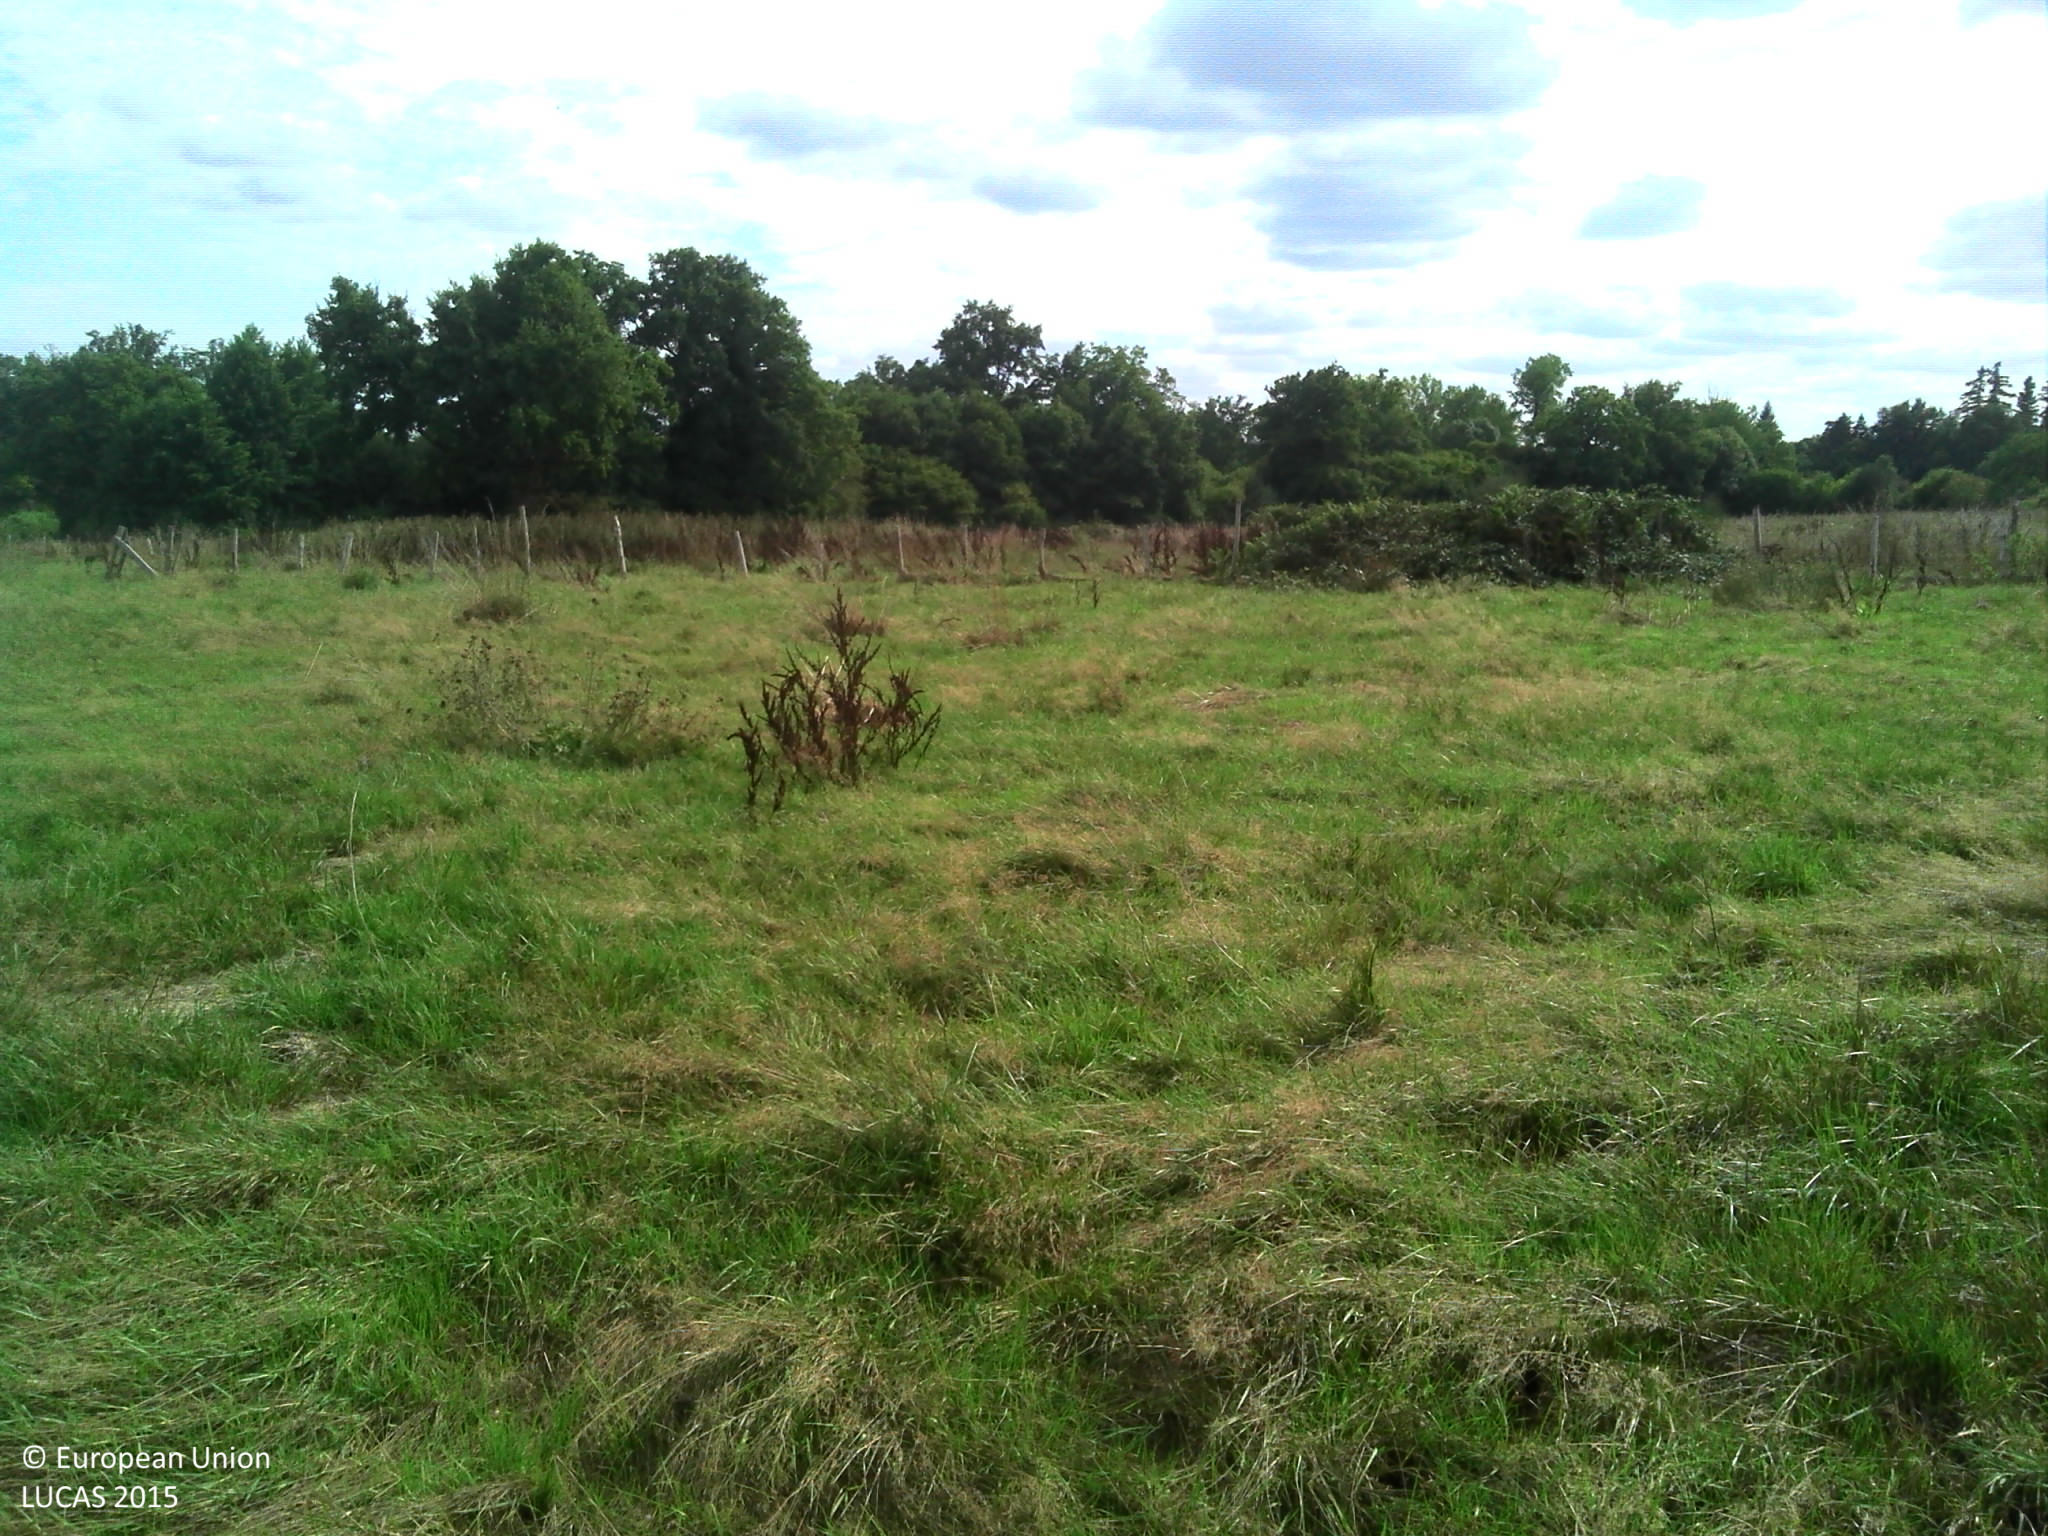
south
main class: Grassland
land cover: Grassland without tree/shrub cover
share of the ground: > 75 %
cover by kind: herbaceous plants 95 %, shrubs 5 %
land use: Agriculture (excluding fallow land and kitchen gardens)
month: August
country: FR
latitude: 46.1708
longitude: 1.2204
